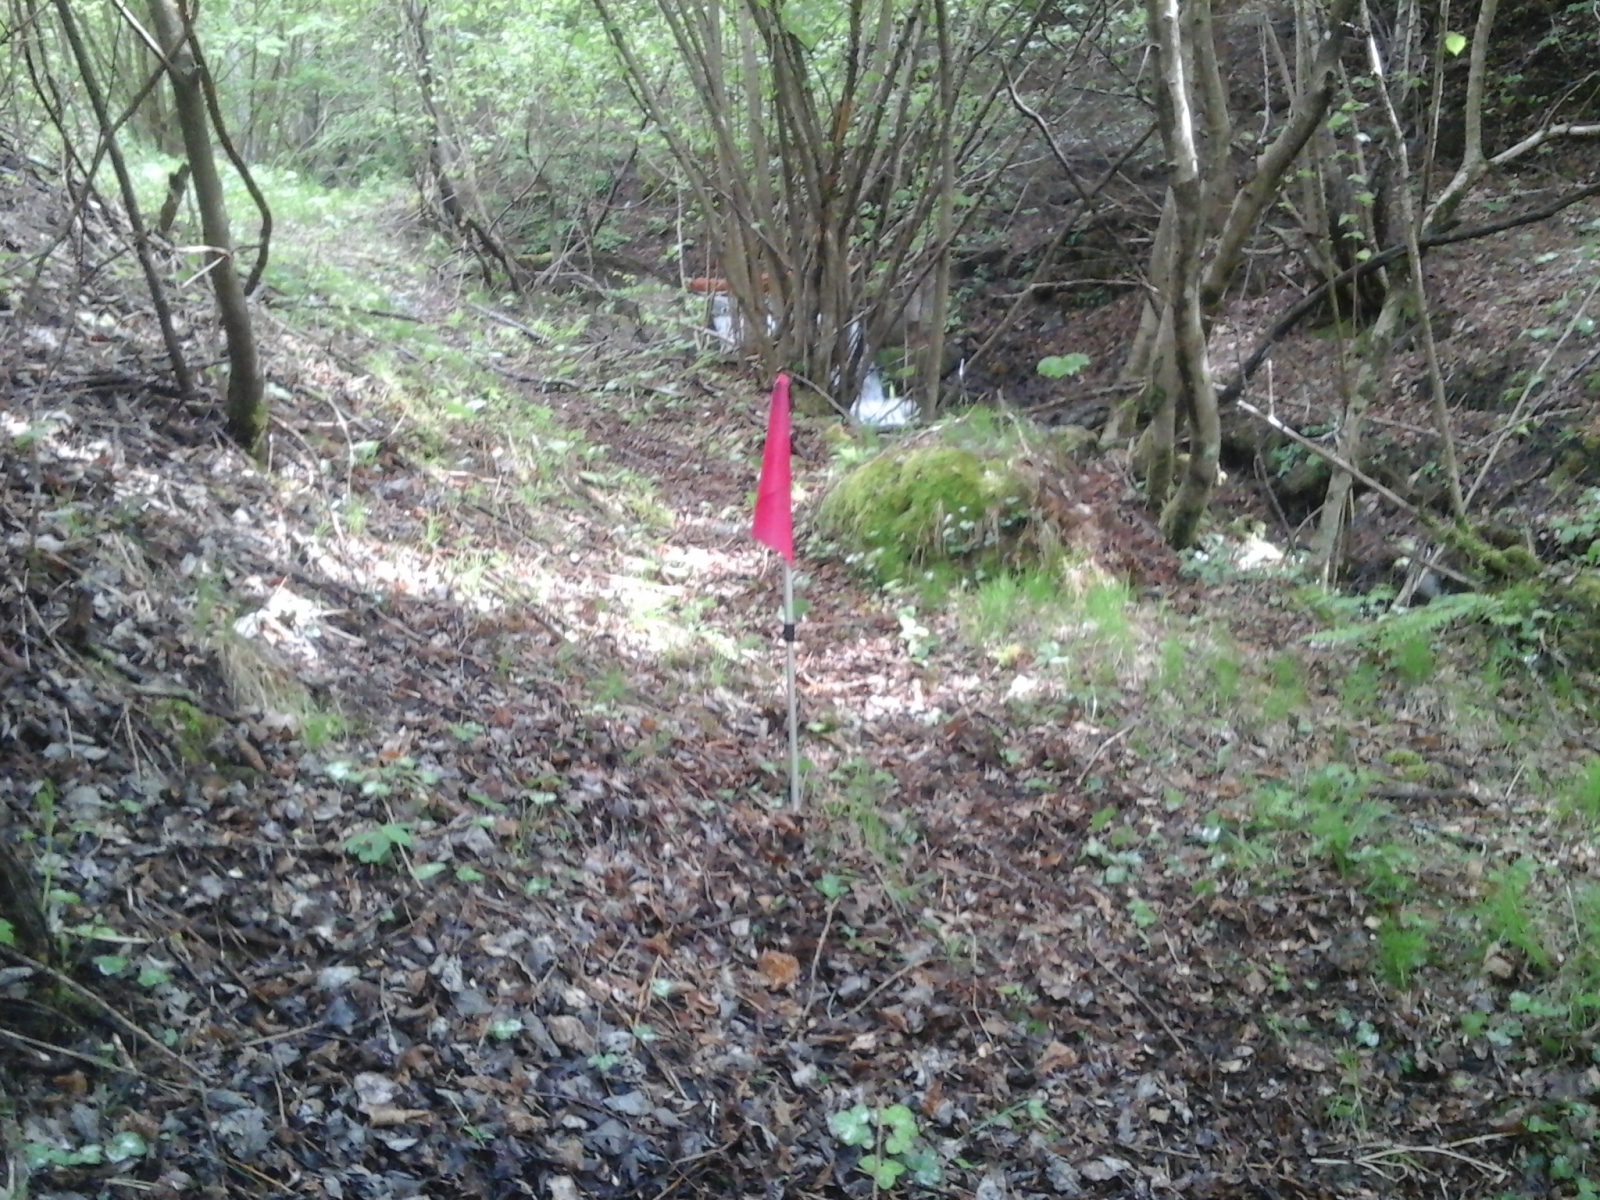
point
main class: Woodland
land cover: Broadleaved woodland
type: mesophytic deciduous forest
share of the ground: > 75 %
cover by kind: broadleaved forest trees 95 %, coniferous forest trees 5 %
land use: Forestry
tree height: > 5 m
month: May
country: IT
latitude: 45.9528
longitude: 10.6570
